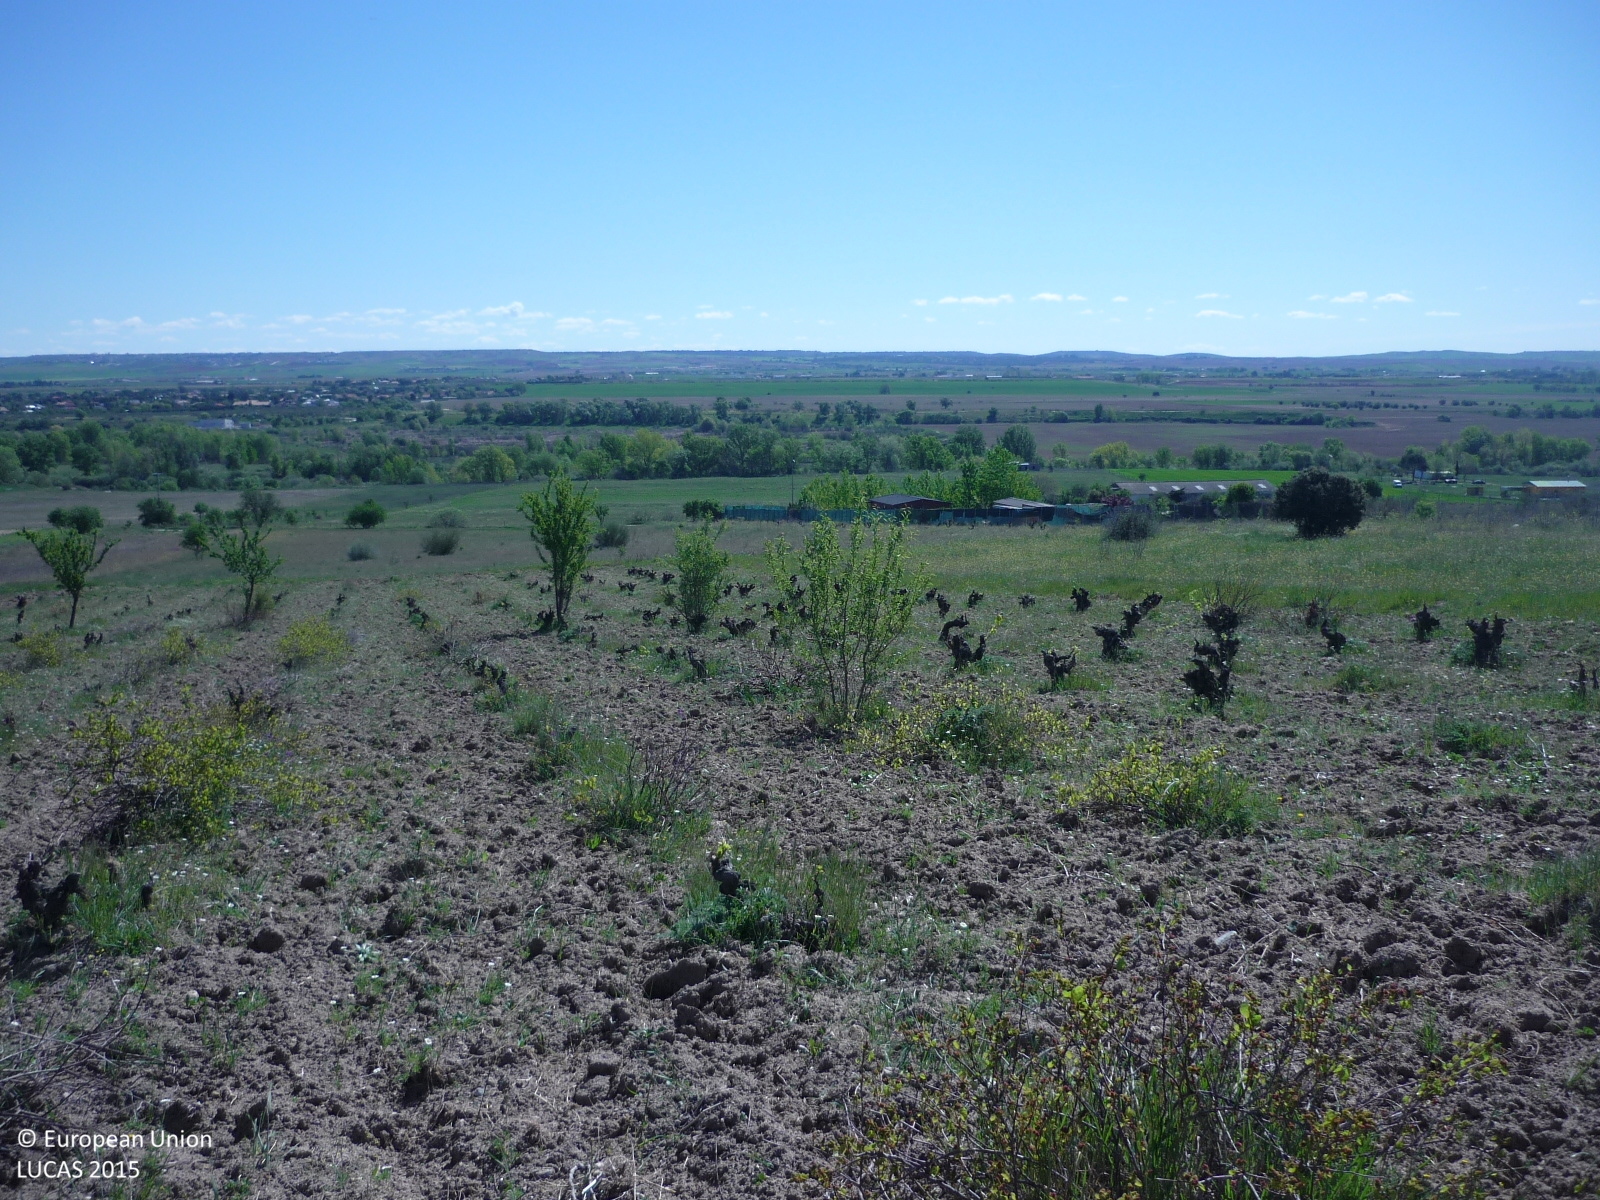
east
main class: Cropland
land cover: Vineyards
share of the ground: < 10 %
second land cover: Other bare soil
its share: > 75 %
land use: Agriculture (excluding fallow land and kitchen gardens)
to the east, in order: Vineyards; Other bare soil; Nuts trees; Vineyards; Electric lines; Spontaneously vegetated surfaces
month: April
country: ES
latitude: 40.6760
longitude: -3.5615
